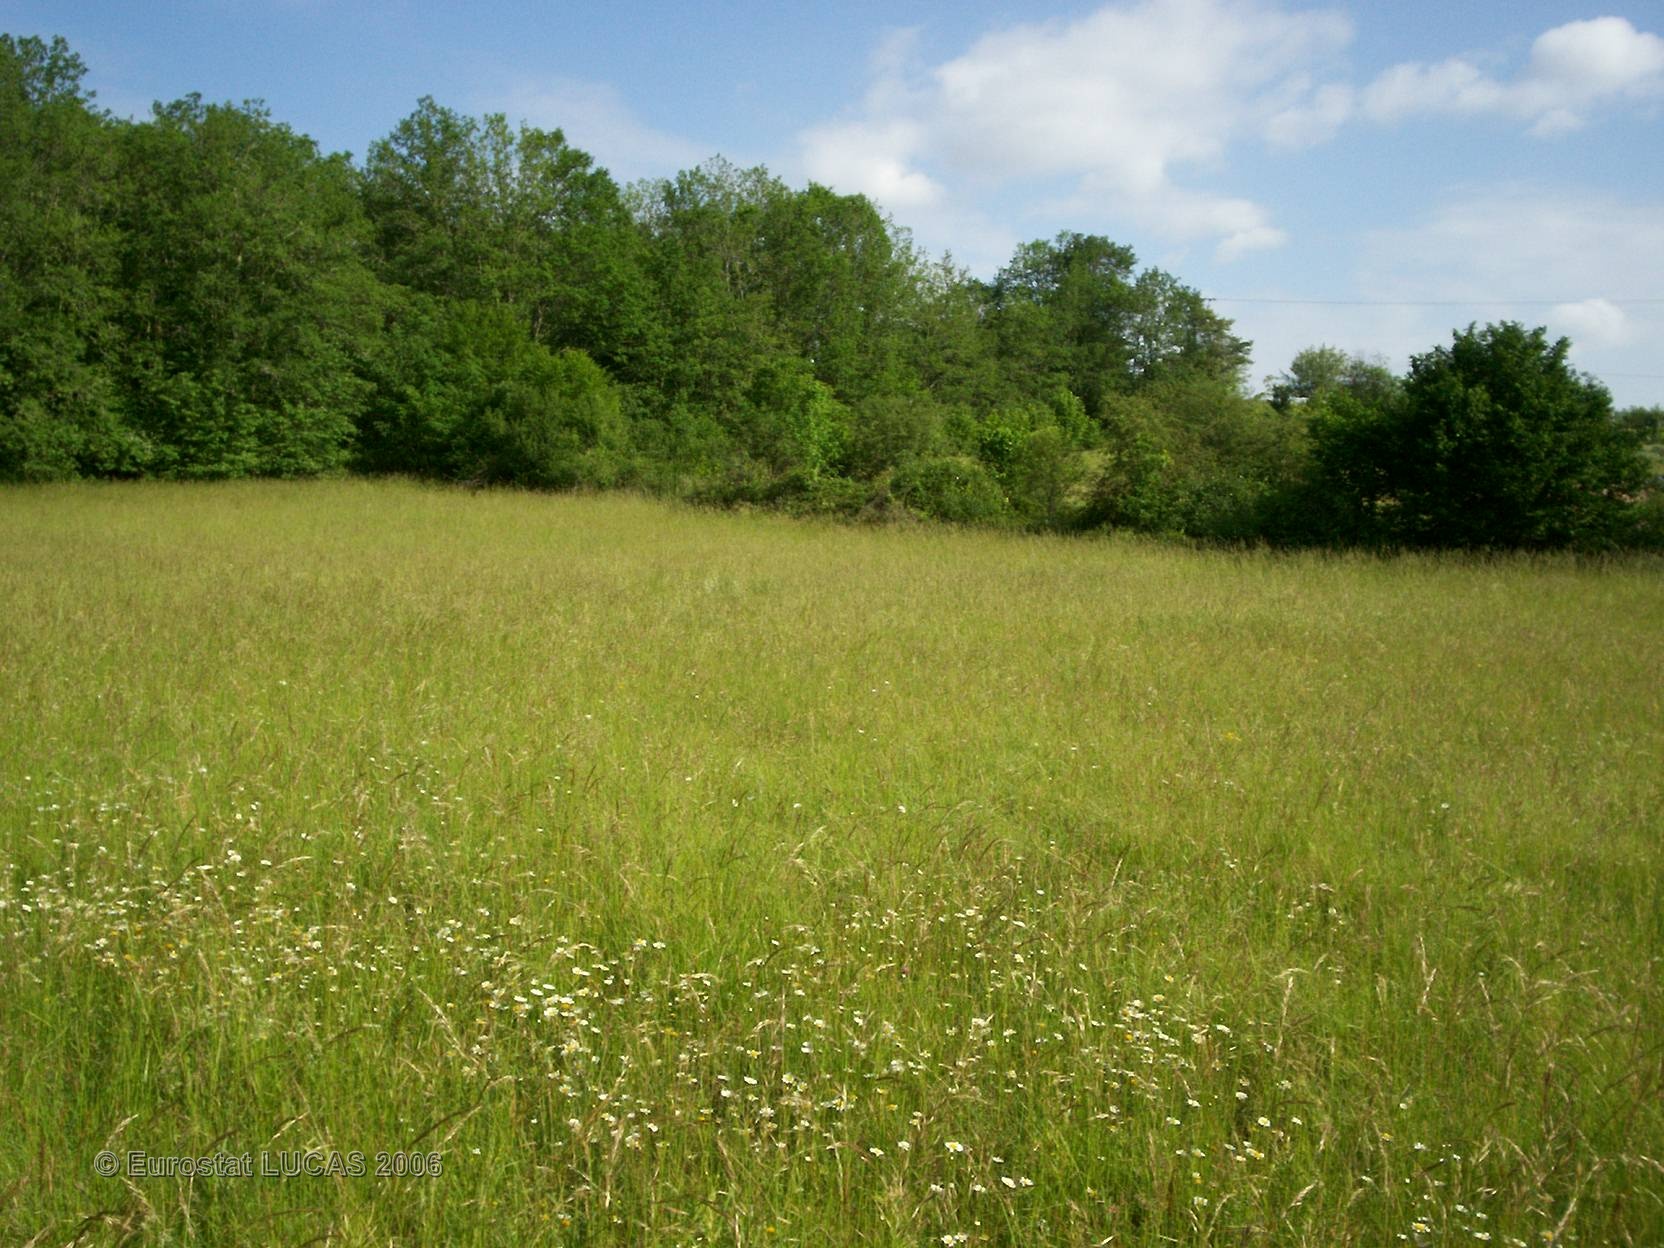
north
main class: Grassland
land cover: Grassland without tree/shrub cover
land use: Agriculture (excluding fallow land and kitchen gardens)
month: May
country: FR
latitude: 45.3590
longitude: 0.6313
